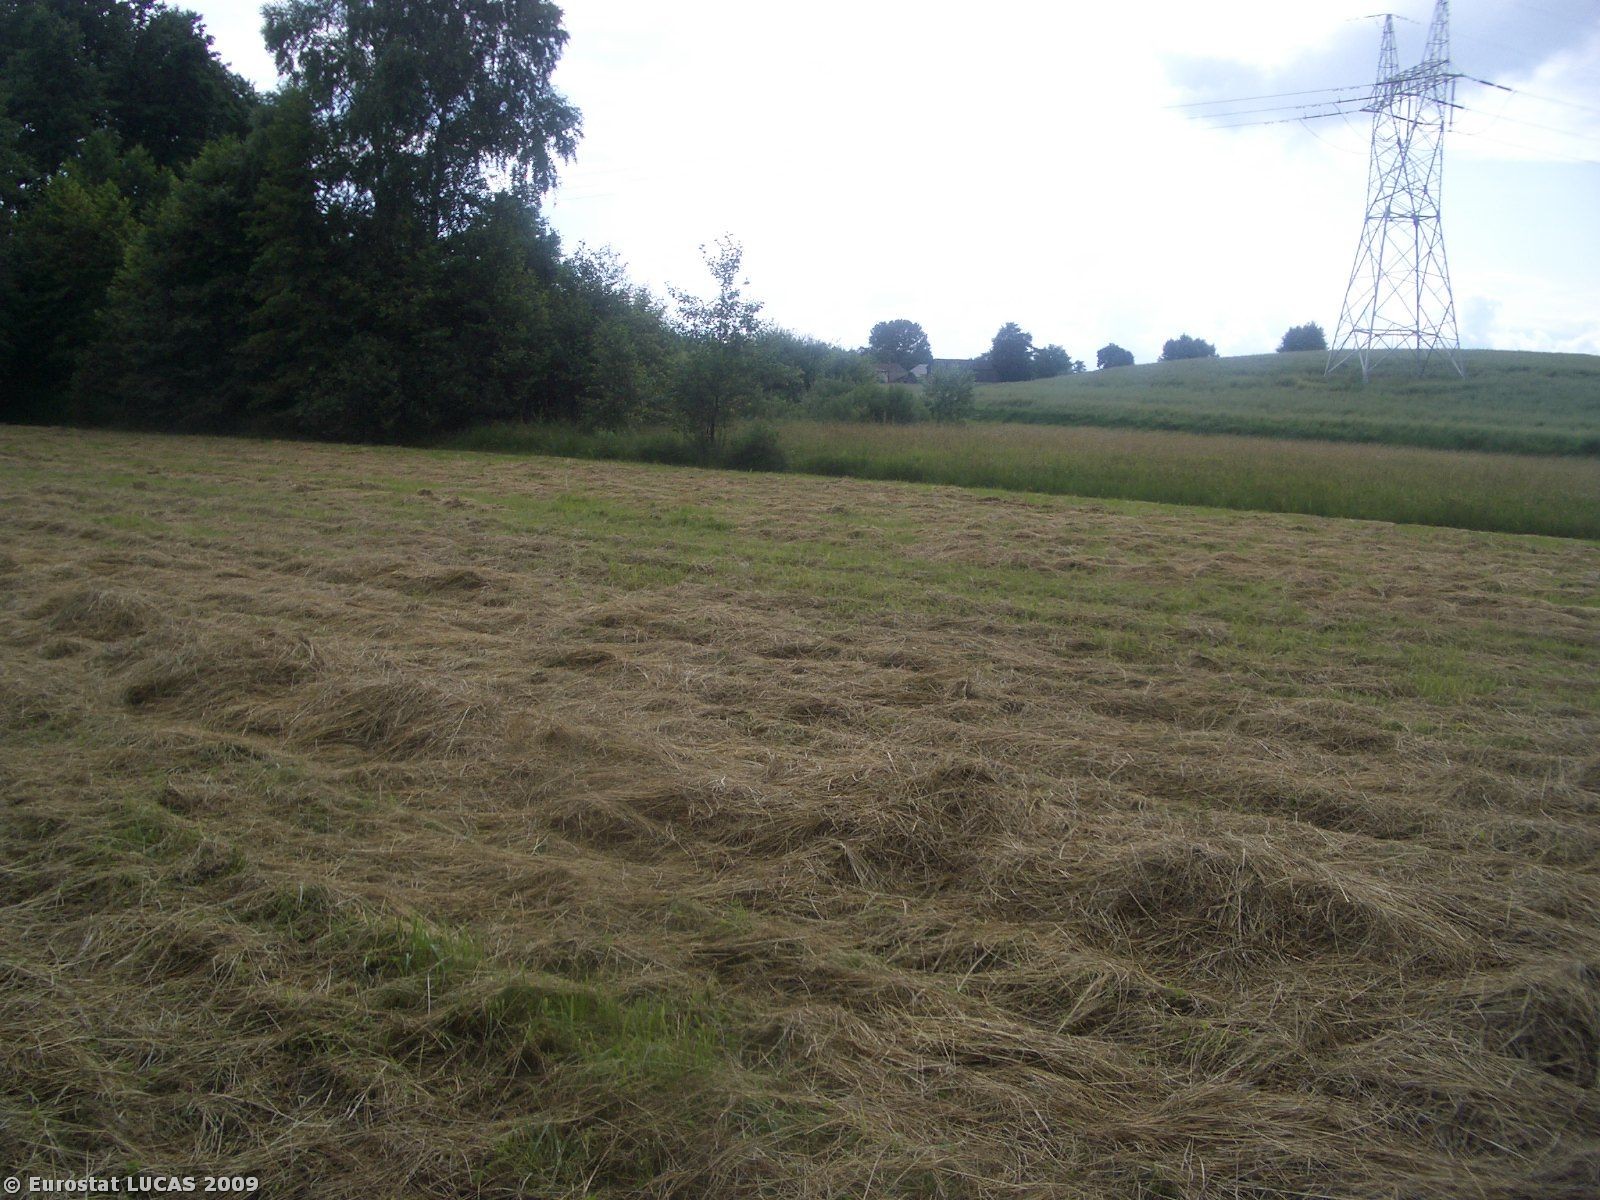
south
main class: Woodland
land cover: Broadleaved woodland
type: mesophytic deciduous forest
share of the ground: > 75 %
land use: Unused
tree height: > 5 m
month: July
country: PL
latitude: 51.3071
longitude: 22.3868
